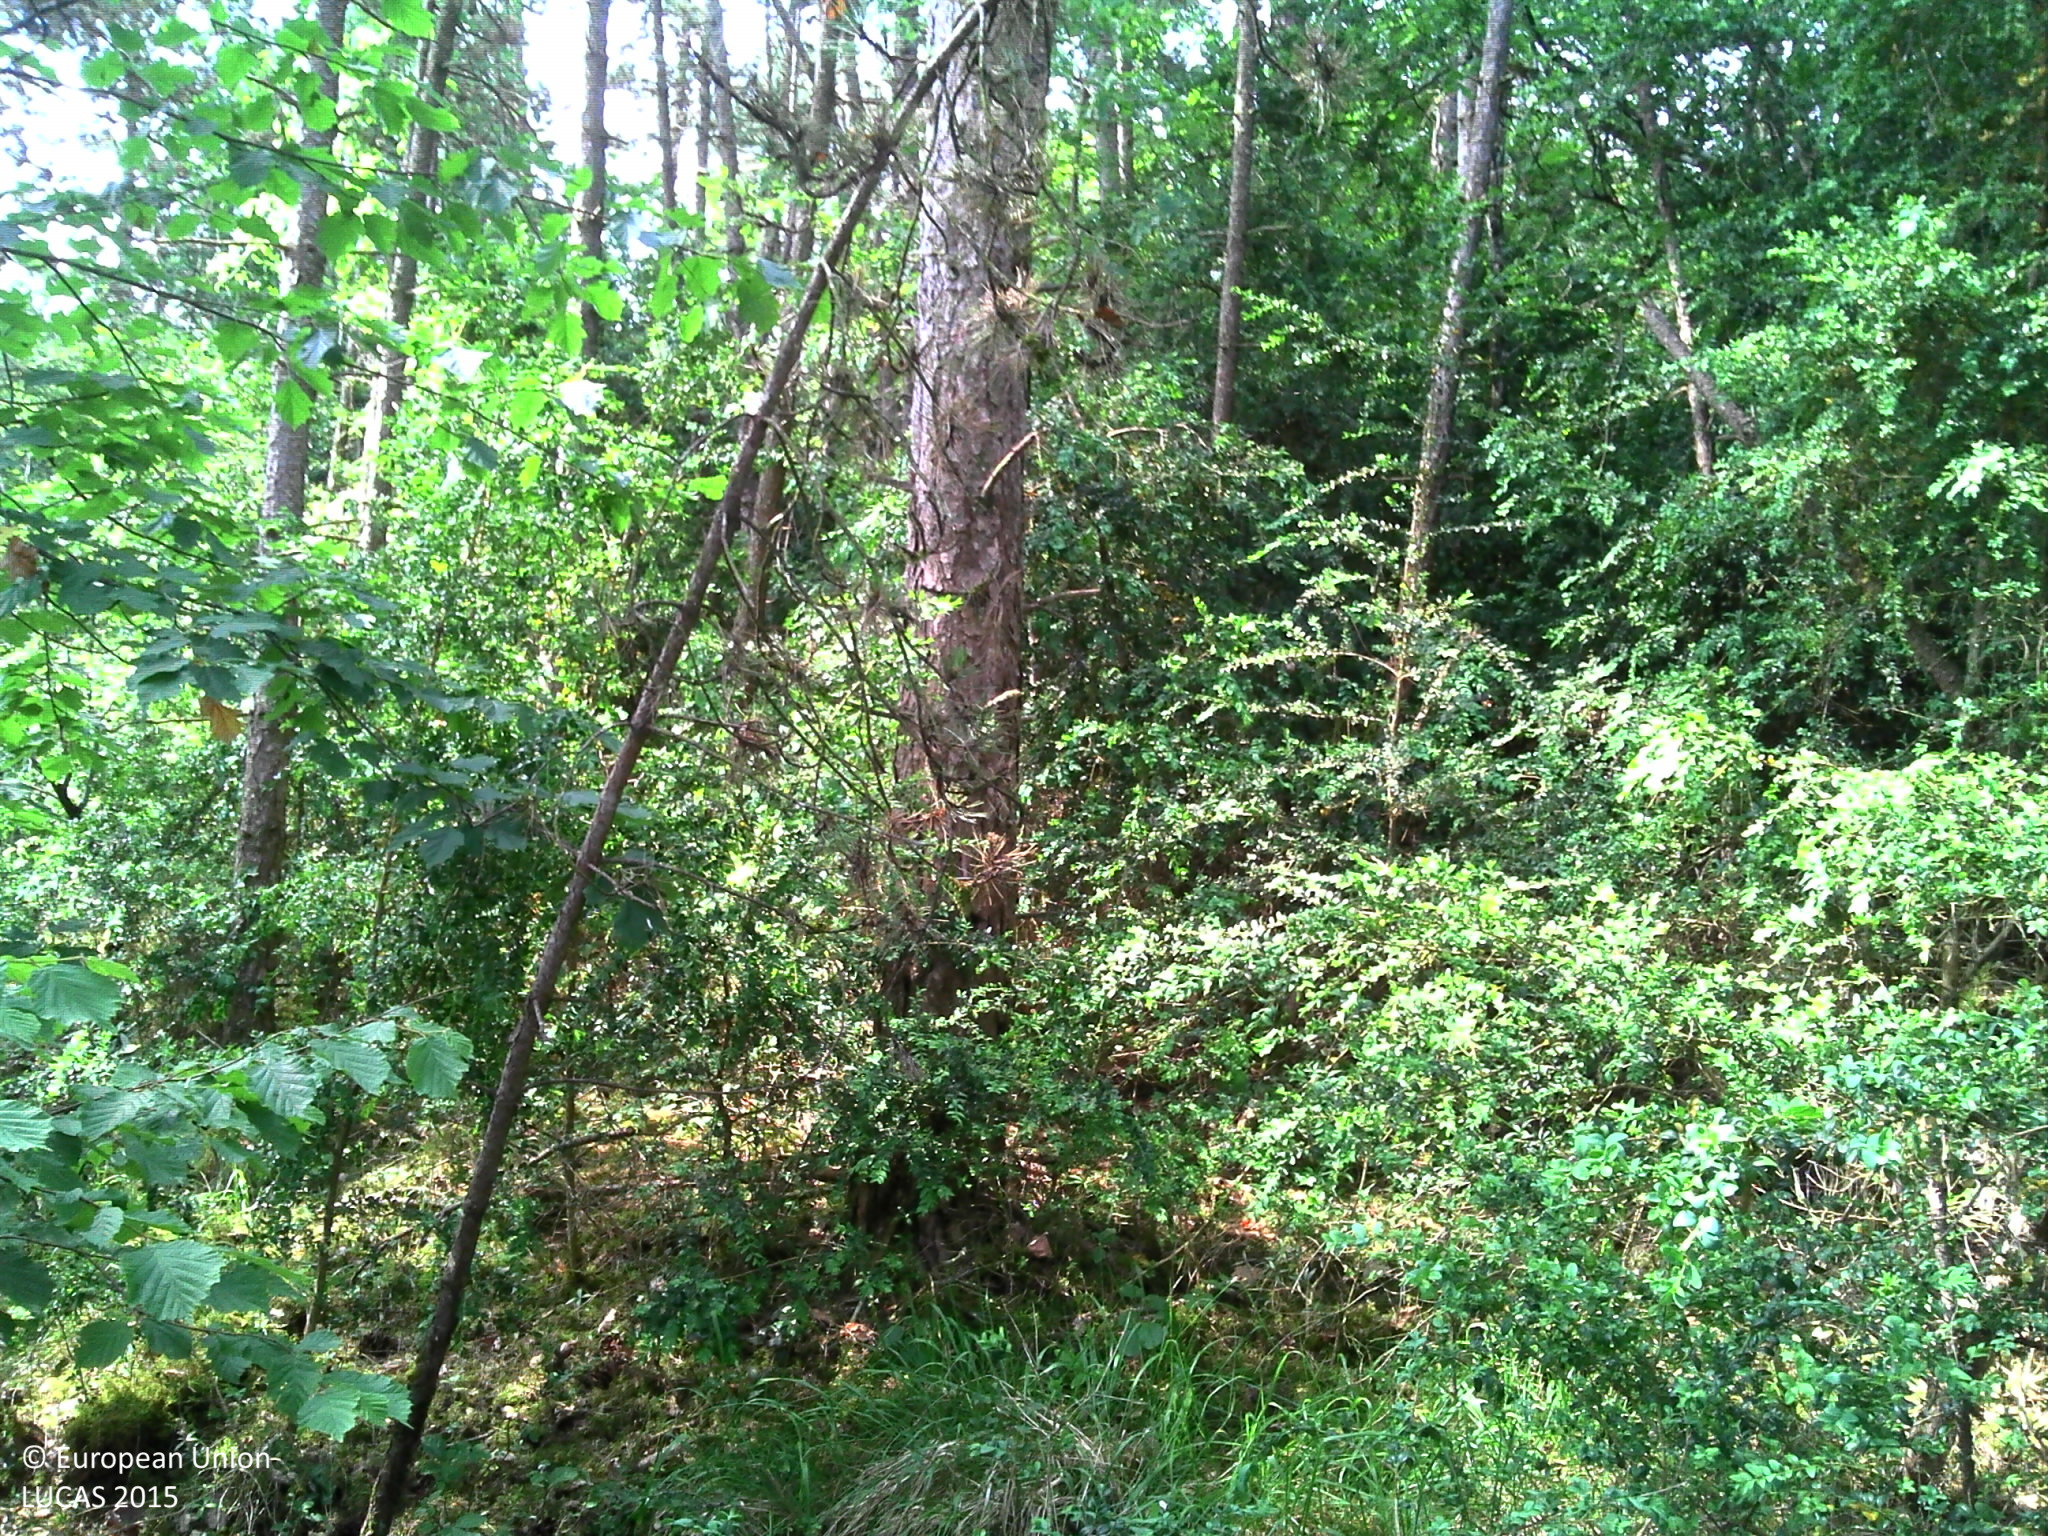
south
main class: Woodland
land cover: Pine dominated mixed woodland
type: hemiboreal forest and nemoral coniferous forest and mixed broadleaved-coniferous forest
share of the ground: > 75 %
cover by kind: coniferous forest trees 50 %, broadleaved forest trees 25 %, shrubs 10 %, lichens and mosses 10 %, herbaceous plants 5 %
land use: Forestry
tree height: > 5 m
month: June
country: FR
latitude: 47.0561
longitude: 4.8269
